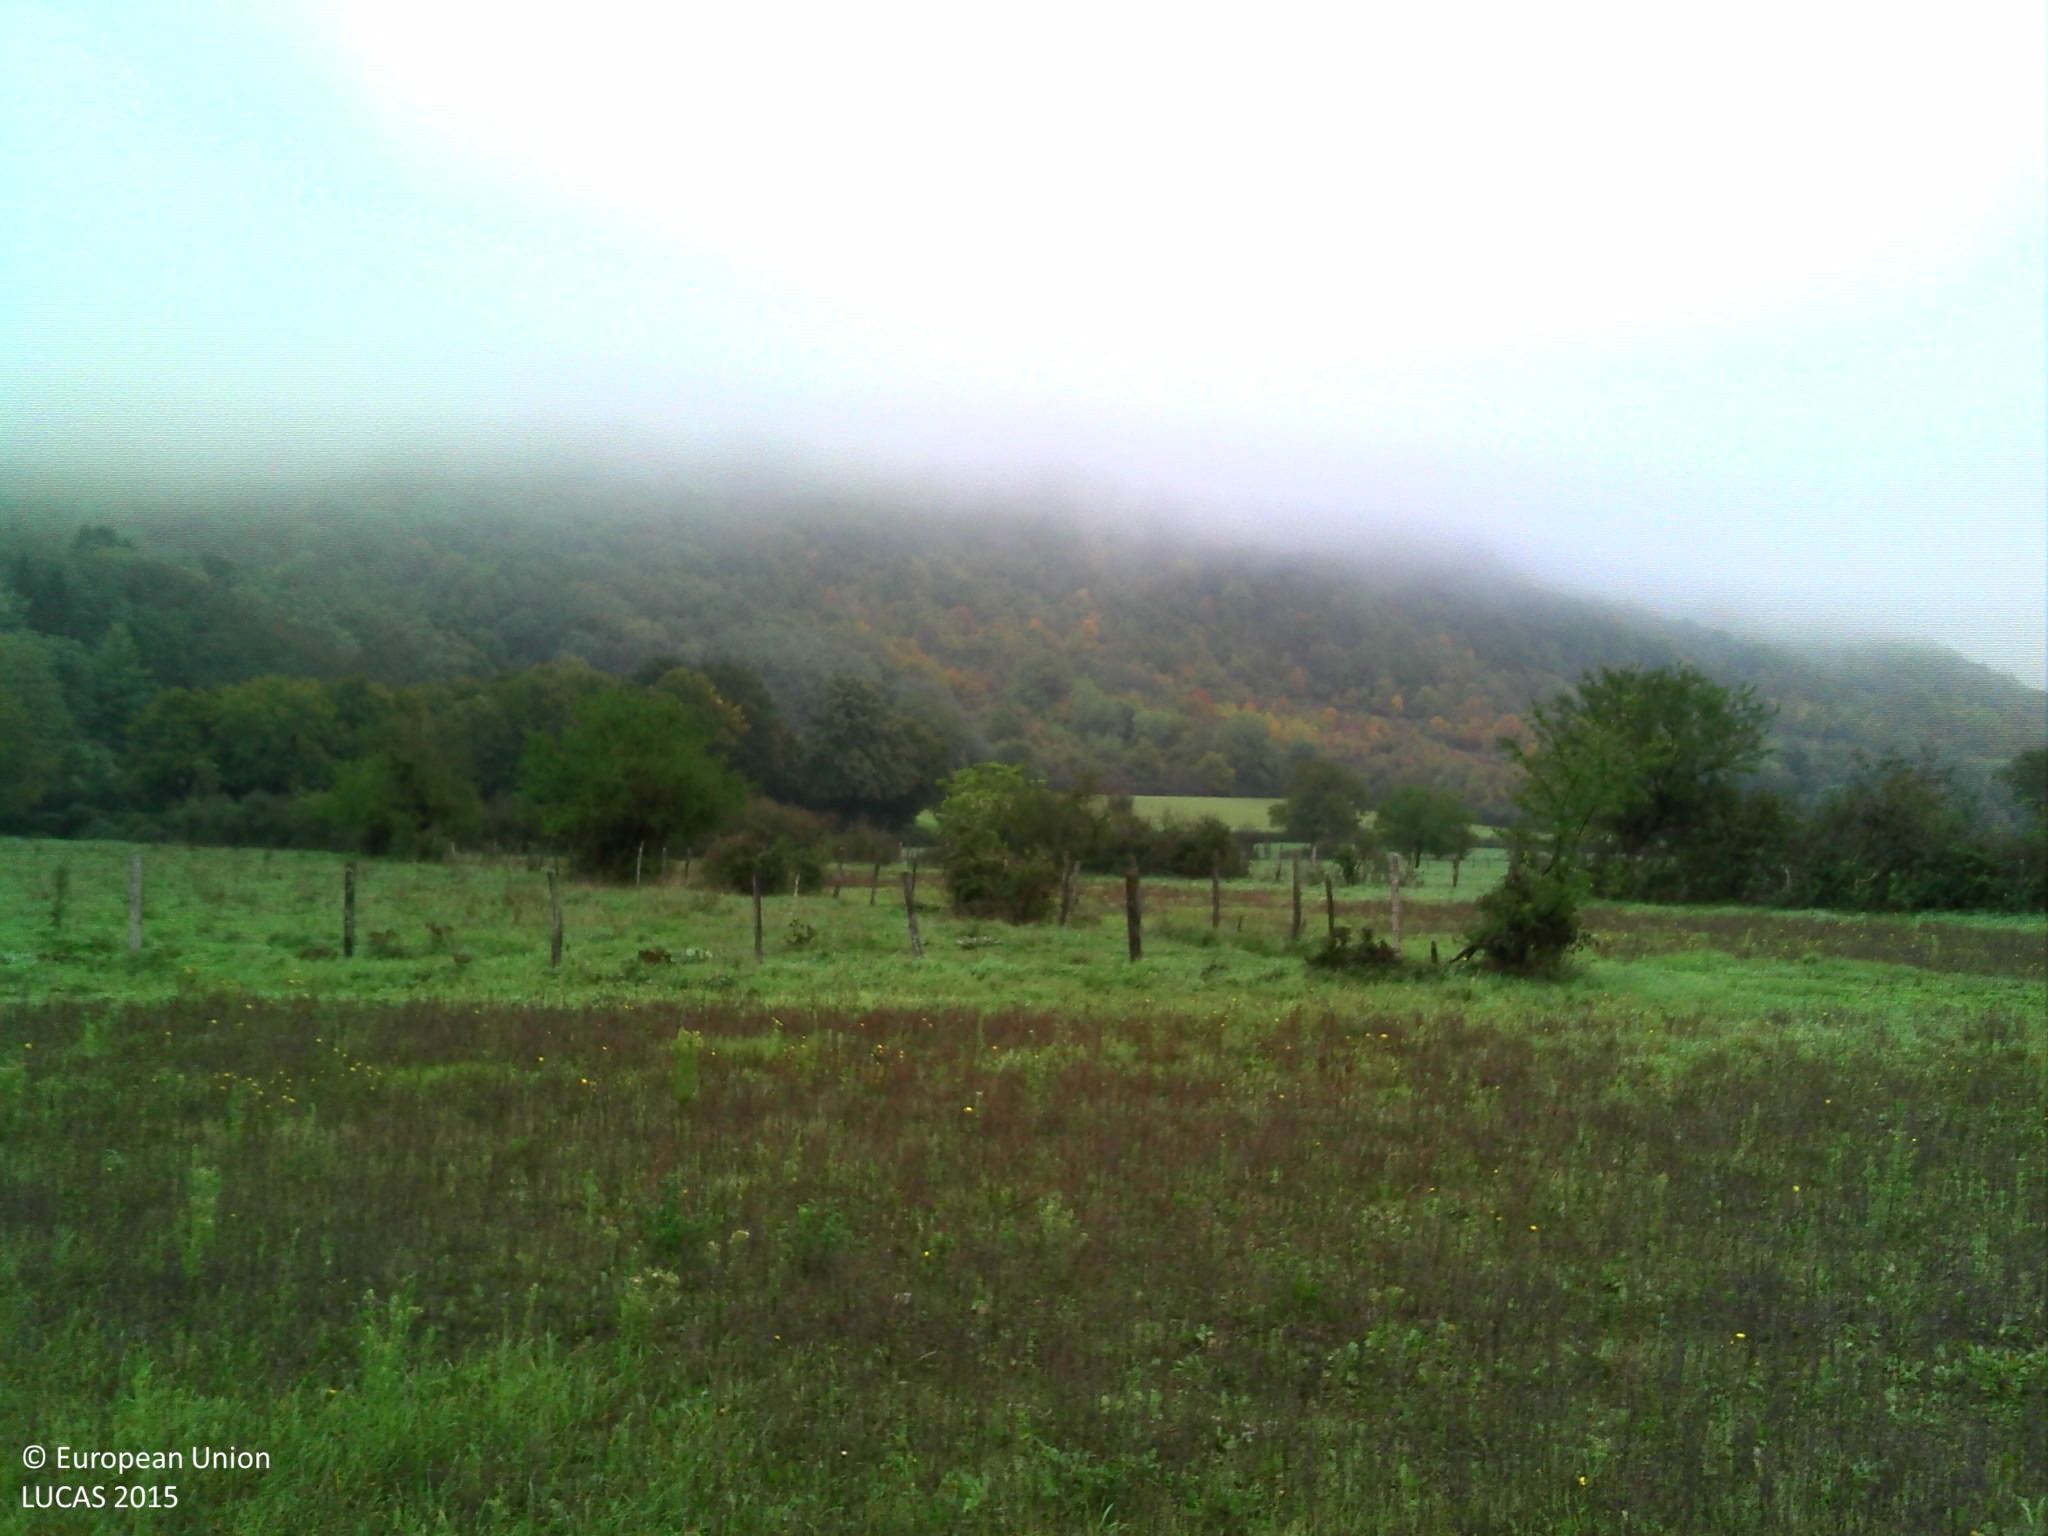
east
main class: Grassland
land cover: Spontaneously vegetated surfaces
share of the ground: > 75 %
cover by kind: herbaceous plants 100 %
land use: Agriculture (excluding fallow land and kitchen gardens)
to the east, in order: Spontaneously vegetated surfaces; Fences; Grassland without tree/shrub cover; Fences; Managed hedges; Grassland without tree/shrub cover; Fences; Managed hedges; Fences; Grassland without tree/shrub cover; Fences; Managed hedges; Ditches and canals; Grass margins; Paved roads, cycling and walking lanes; Grass margins; Dry stone walls; Ditches and canals; Broadleaved woodland; Artificial constructions in urban areas
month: October
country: FR
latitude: 45.8387
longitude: 5.4332
